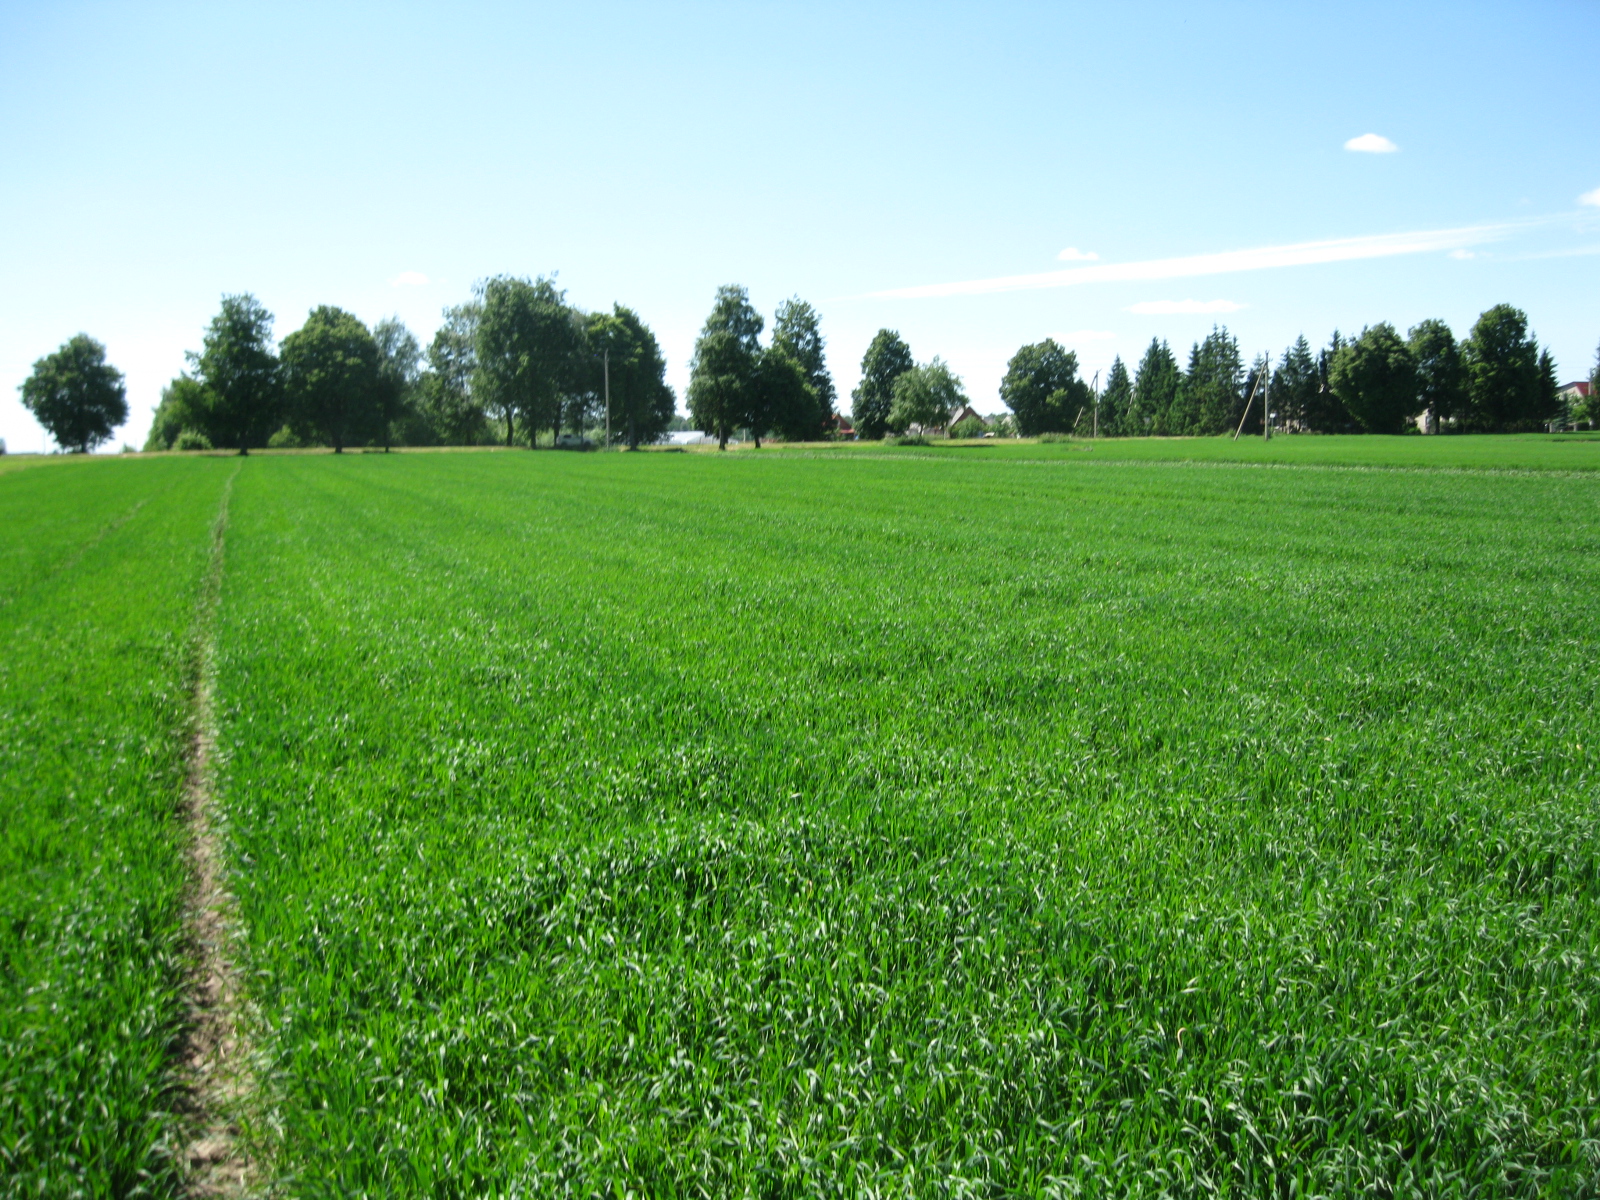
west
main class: Cropland
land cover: Triticale
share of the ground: > 75 %
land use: Agriculture (excluding fallow land and kitchen gardens)
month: June
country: LT
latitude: 55.2771
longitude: 23.9254
